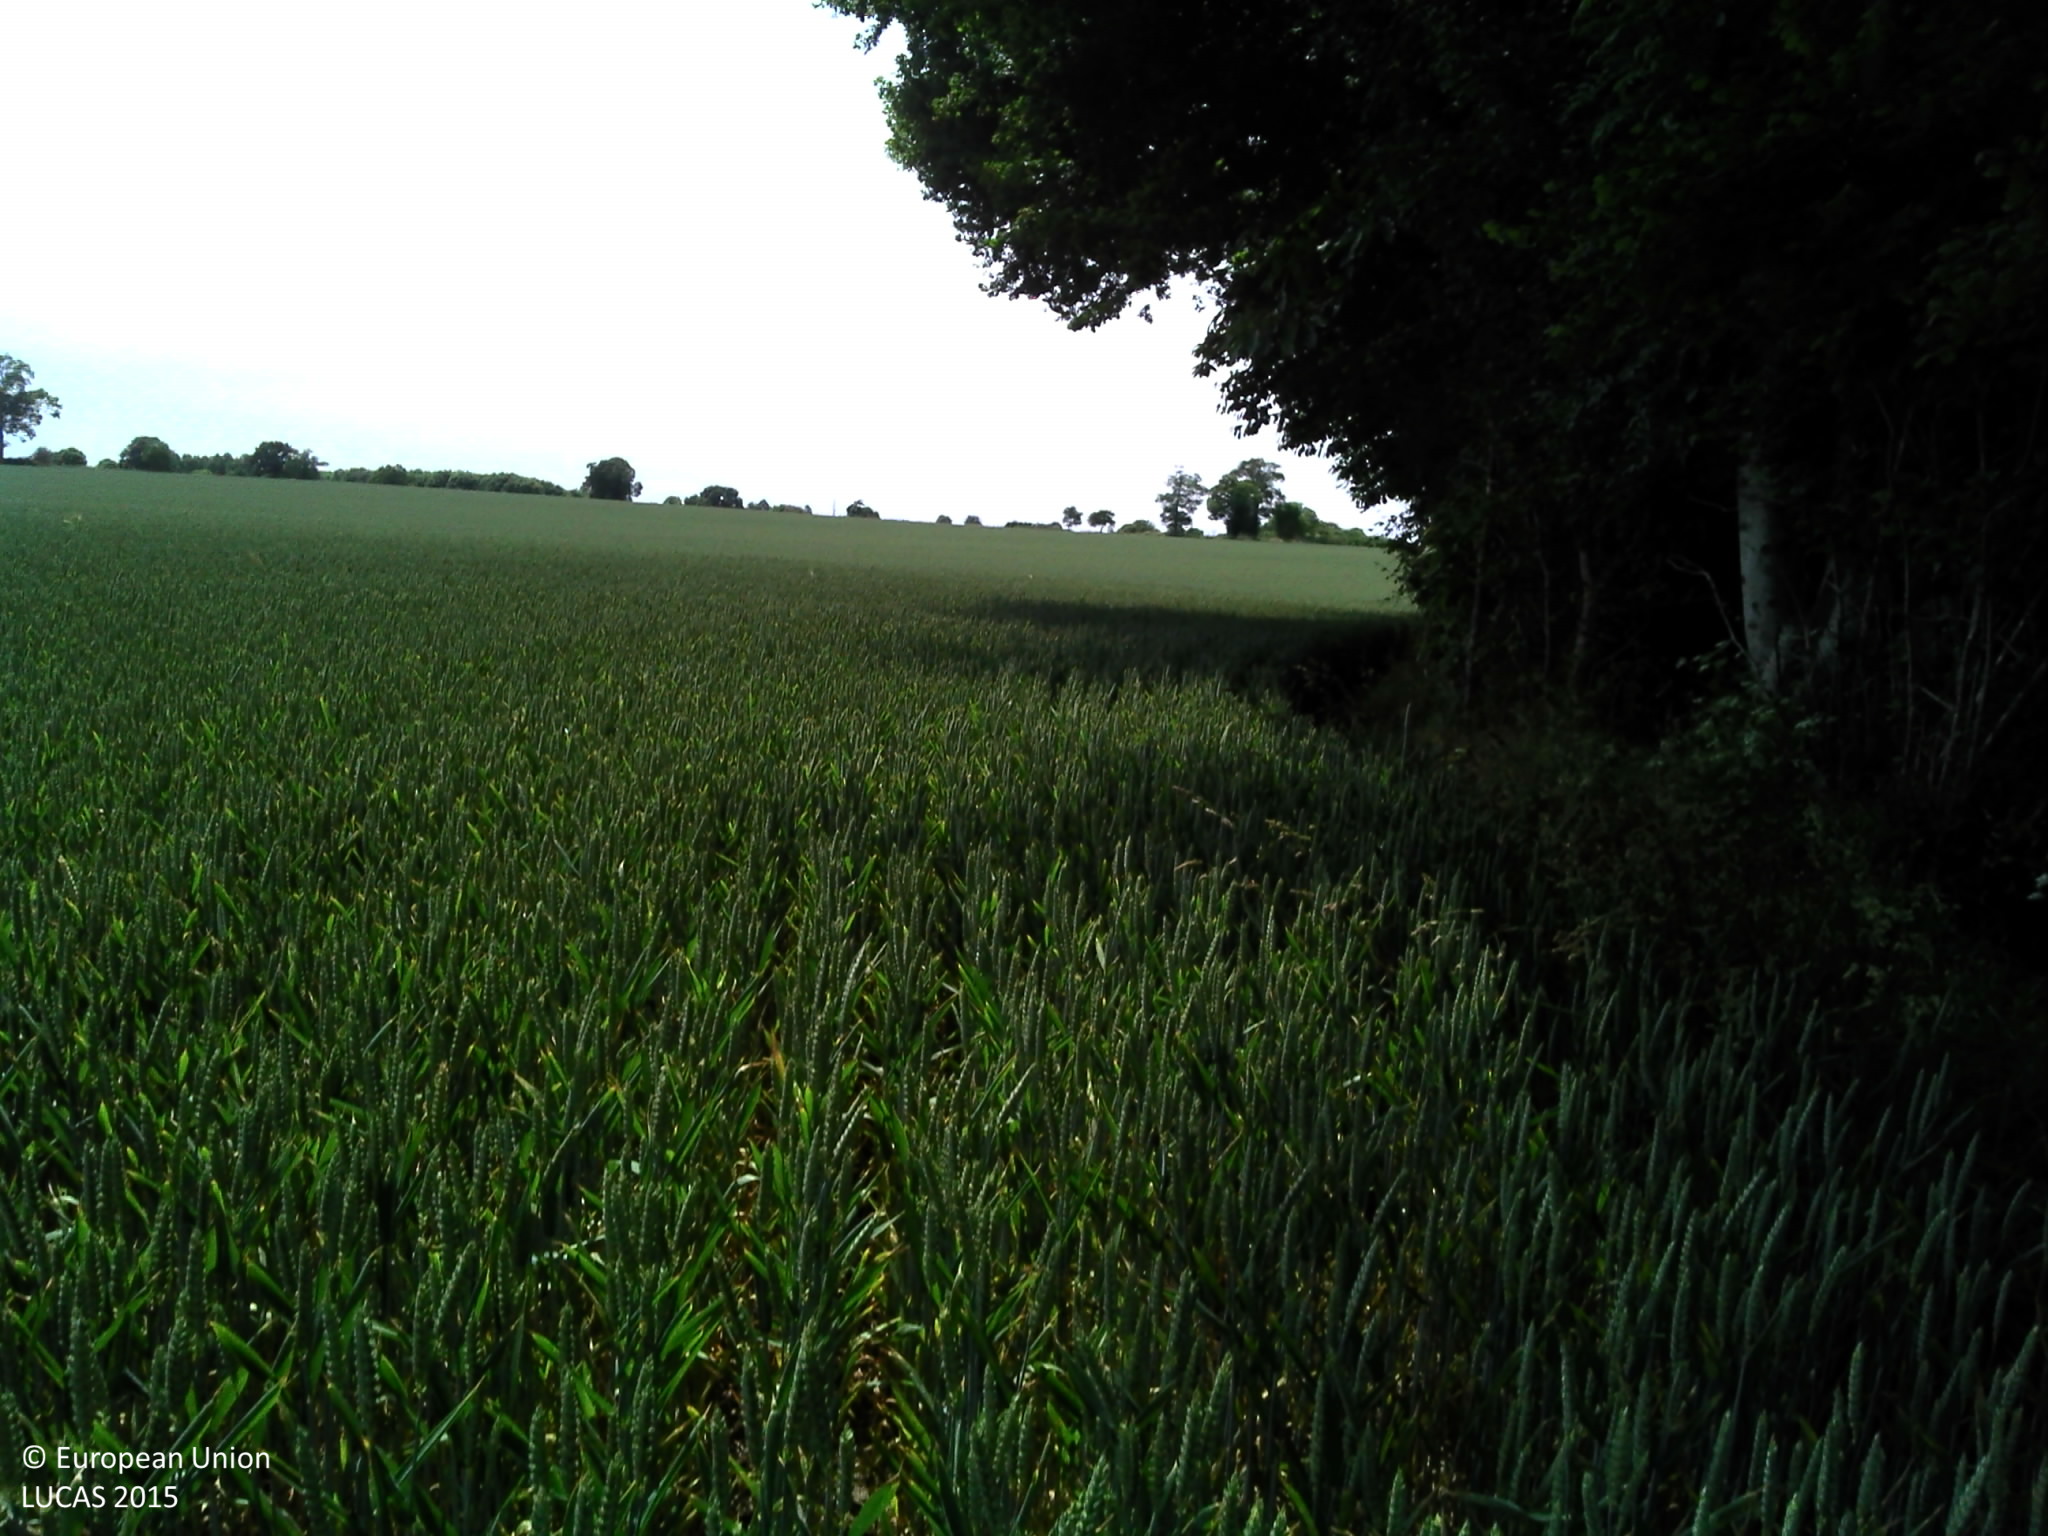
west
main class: Cropland
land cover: Common wheat
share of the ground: > 75 %
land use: Agriculture (excluding fallow land and kitchen gardens)
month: June
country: FR
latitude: 48.3668
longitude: -1.4794
